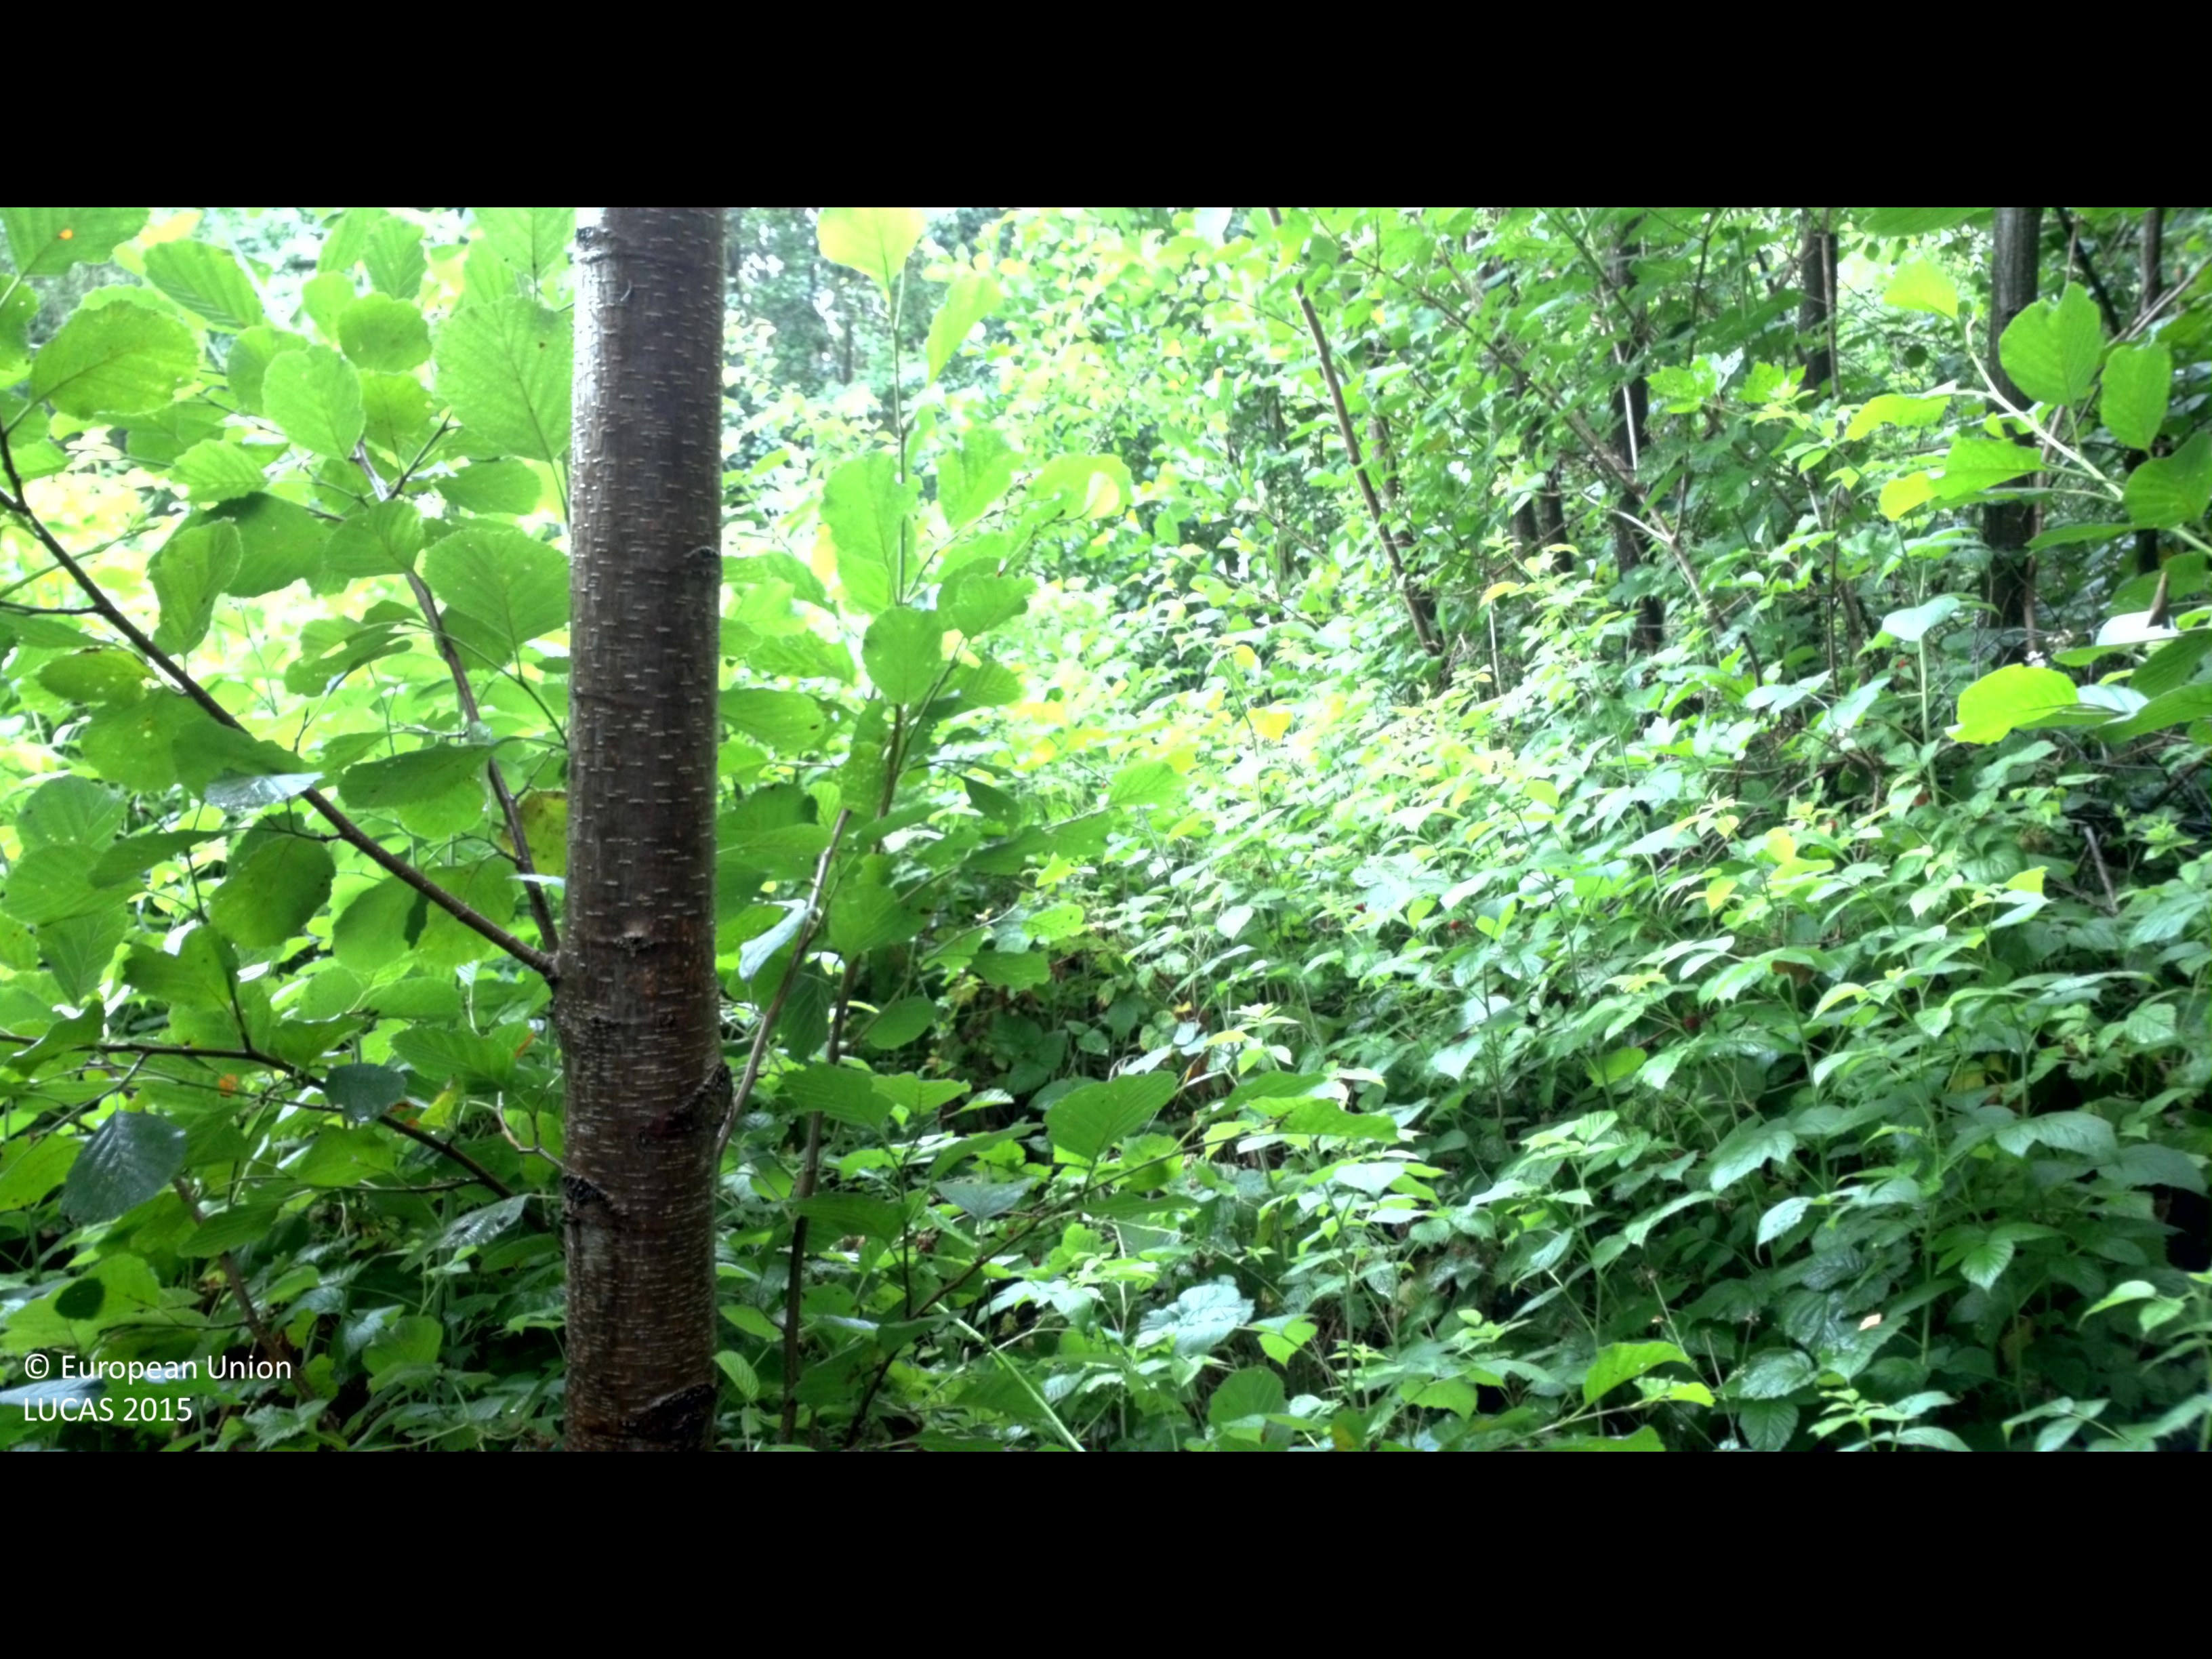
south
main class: Woodland
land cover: Broadleaved woodland
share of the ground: > 75 %
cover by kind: broadleaved forest trees 80 %, shrubs 20 %
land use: Amenities, museums, leisure
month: July
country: SE
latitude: 56.6378
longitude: 16.4743
